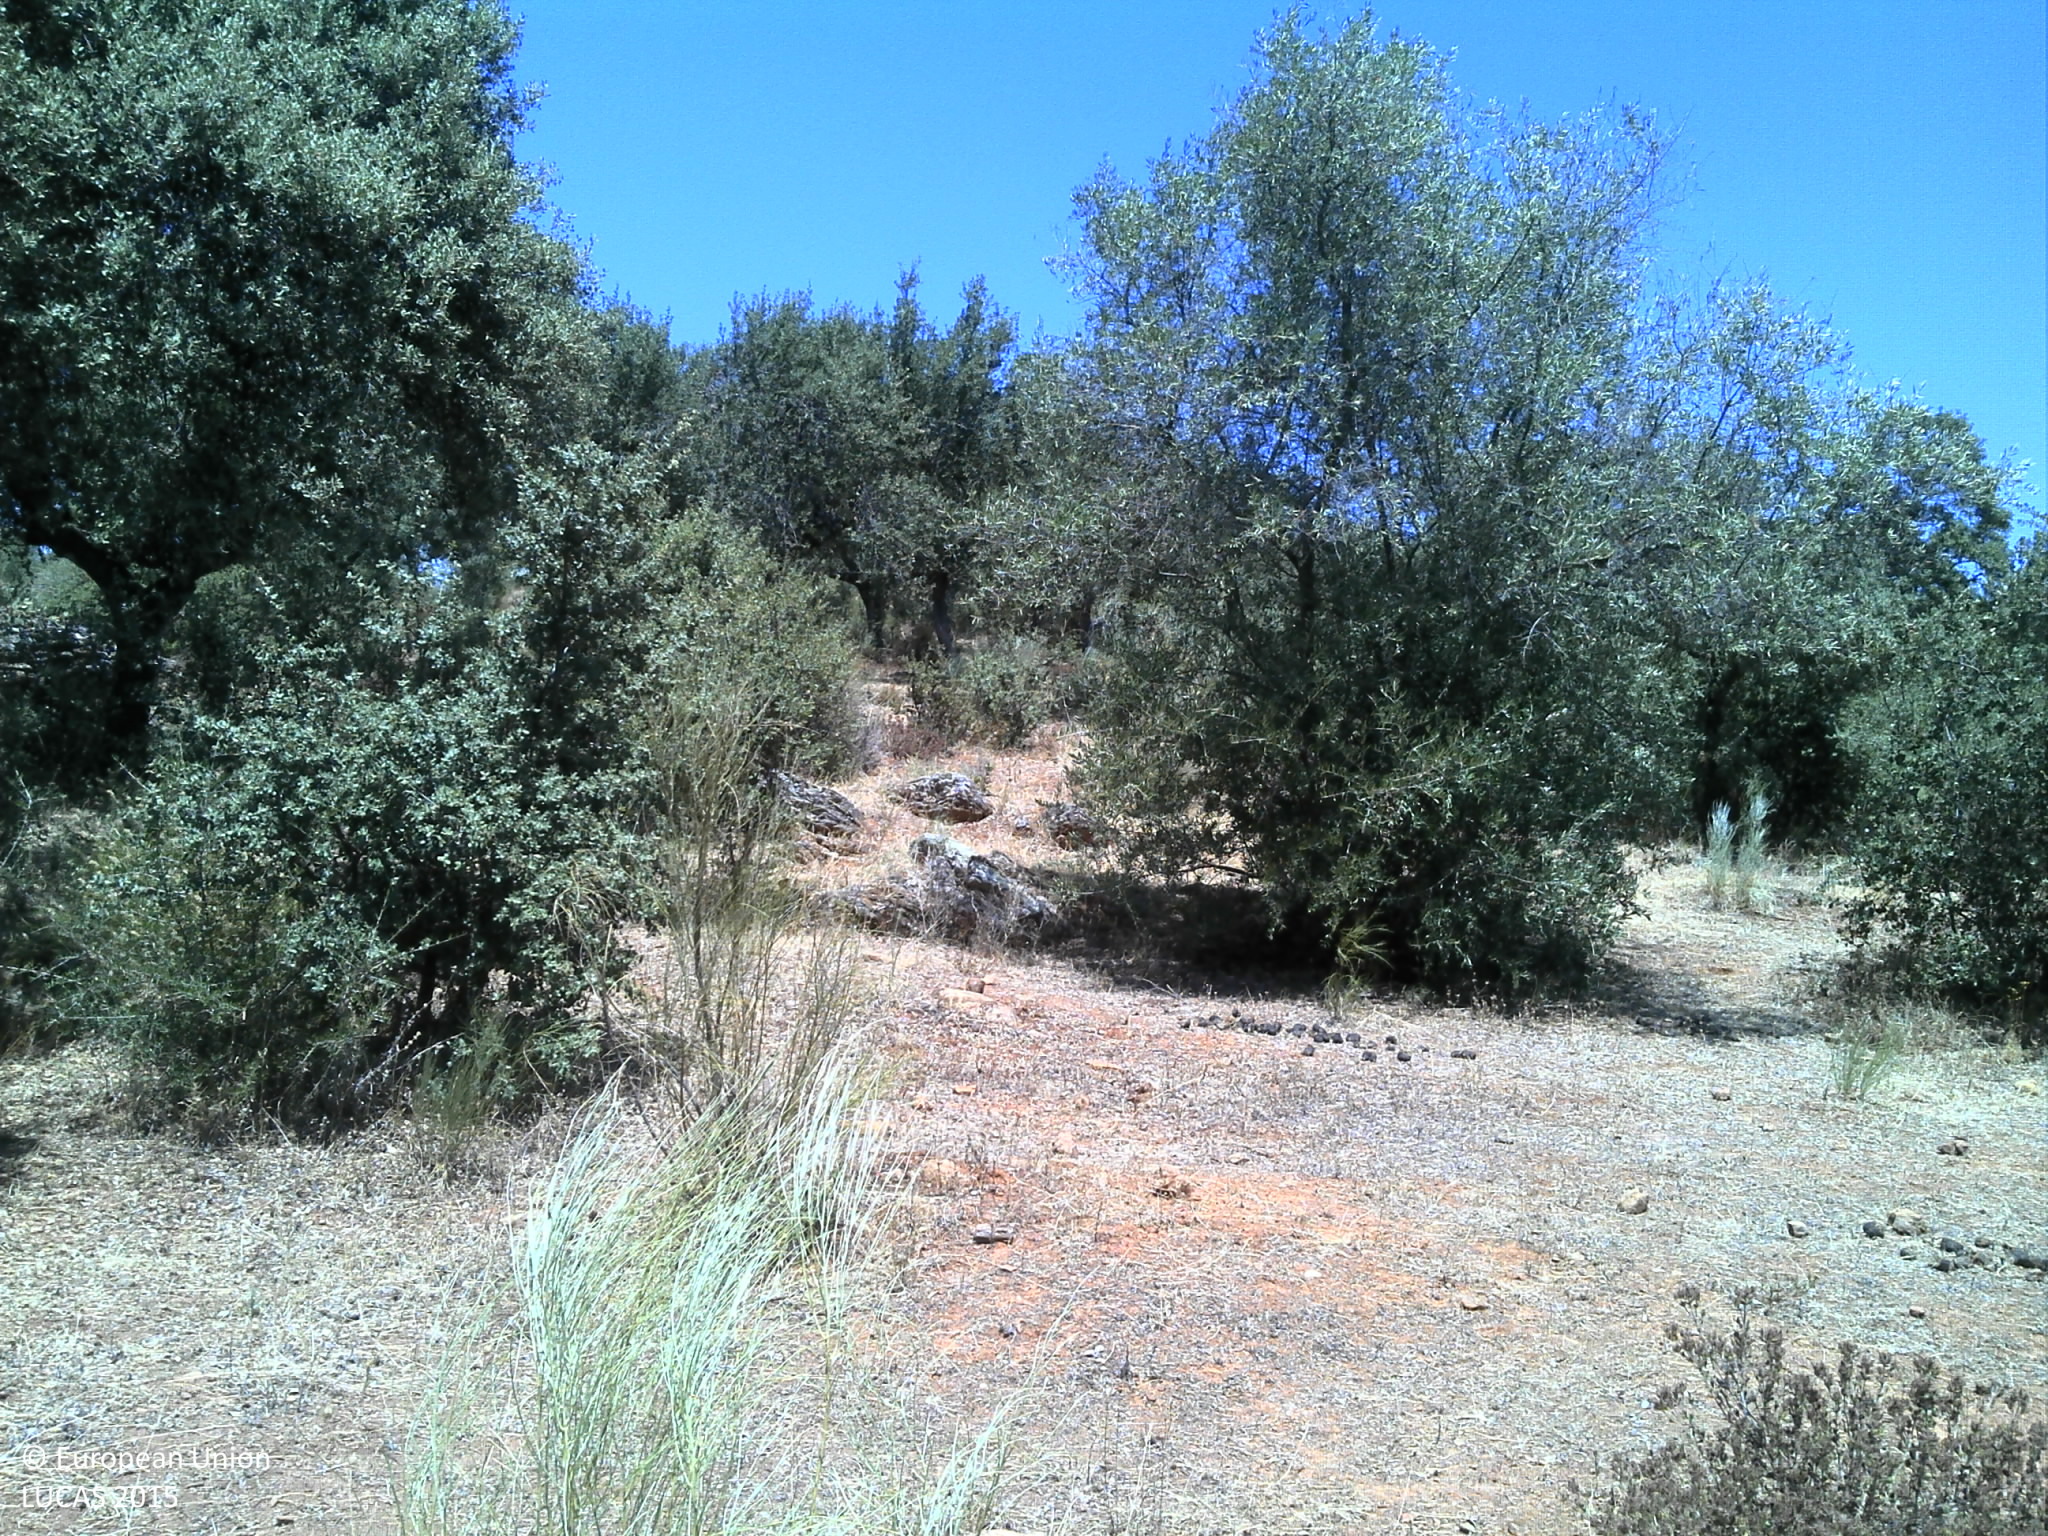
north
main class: Woodland
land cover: Broadleaved woodland
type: broadleaved evergreen forest
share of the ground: 25 - 50 %
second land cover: Shrubland without tree cover
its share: 50 - 75 %
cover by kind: shrubs 50 %, broadleaved forest trees 30 %, unconsolidated bare surface 20 %
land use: Forestry
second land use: Agriculture (excluding fallow land and kitchen gardens)
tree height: > 5 m
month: July
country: PT
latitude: 38.8367
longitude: -7.2519
